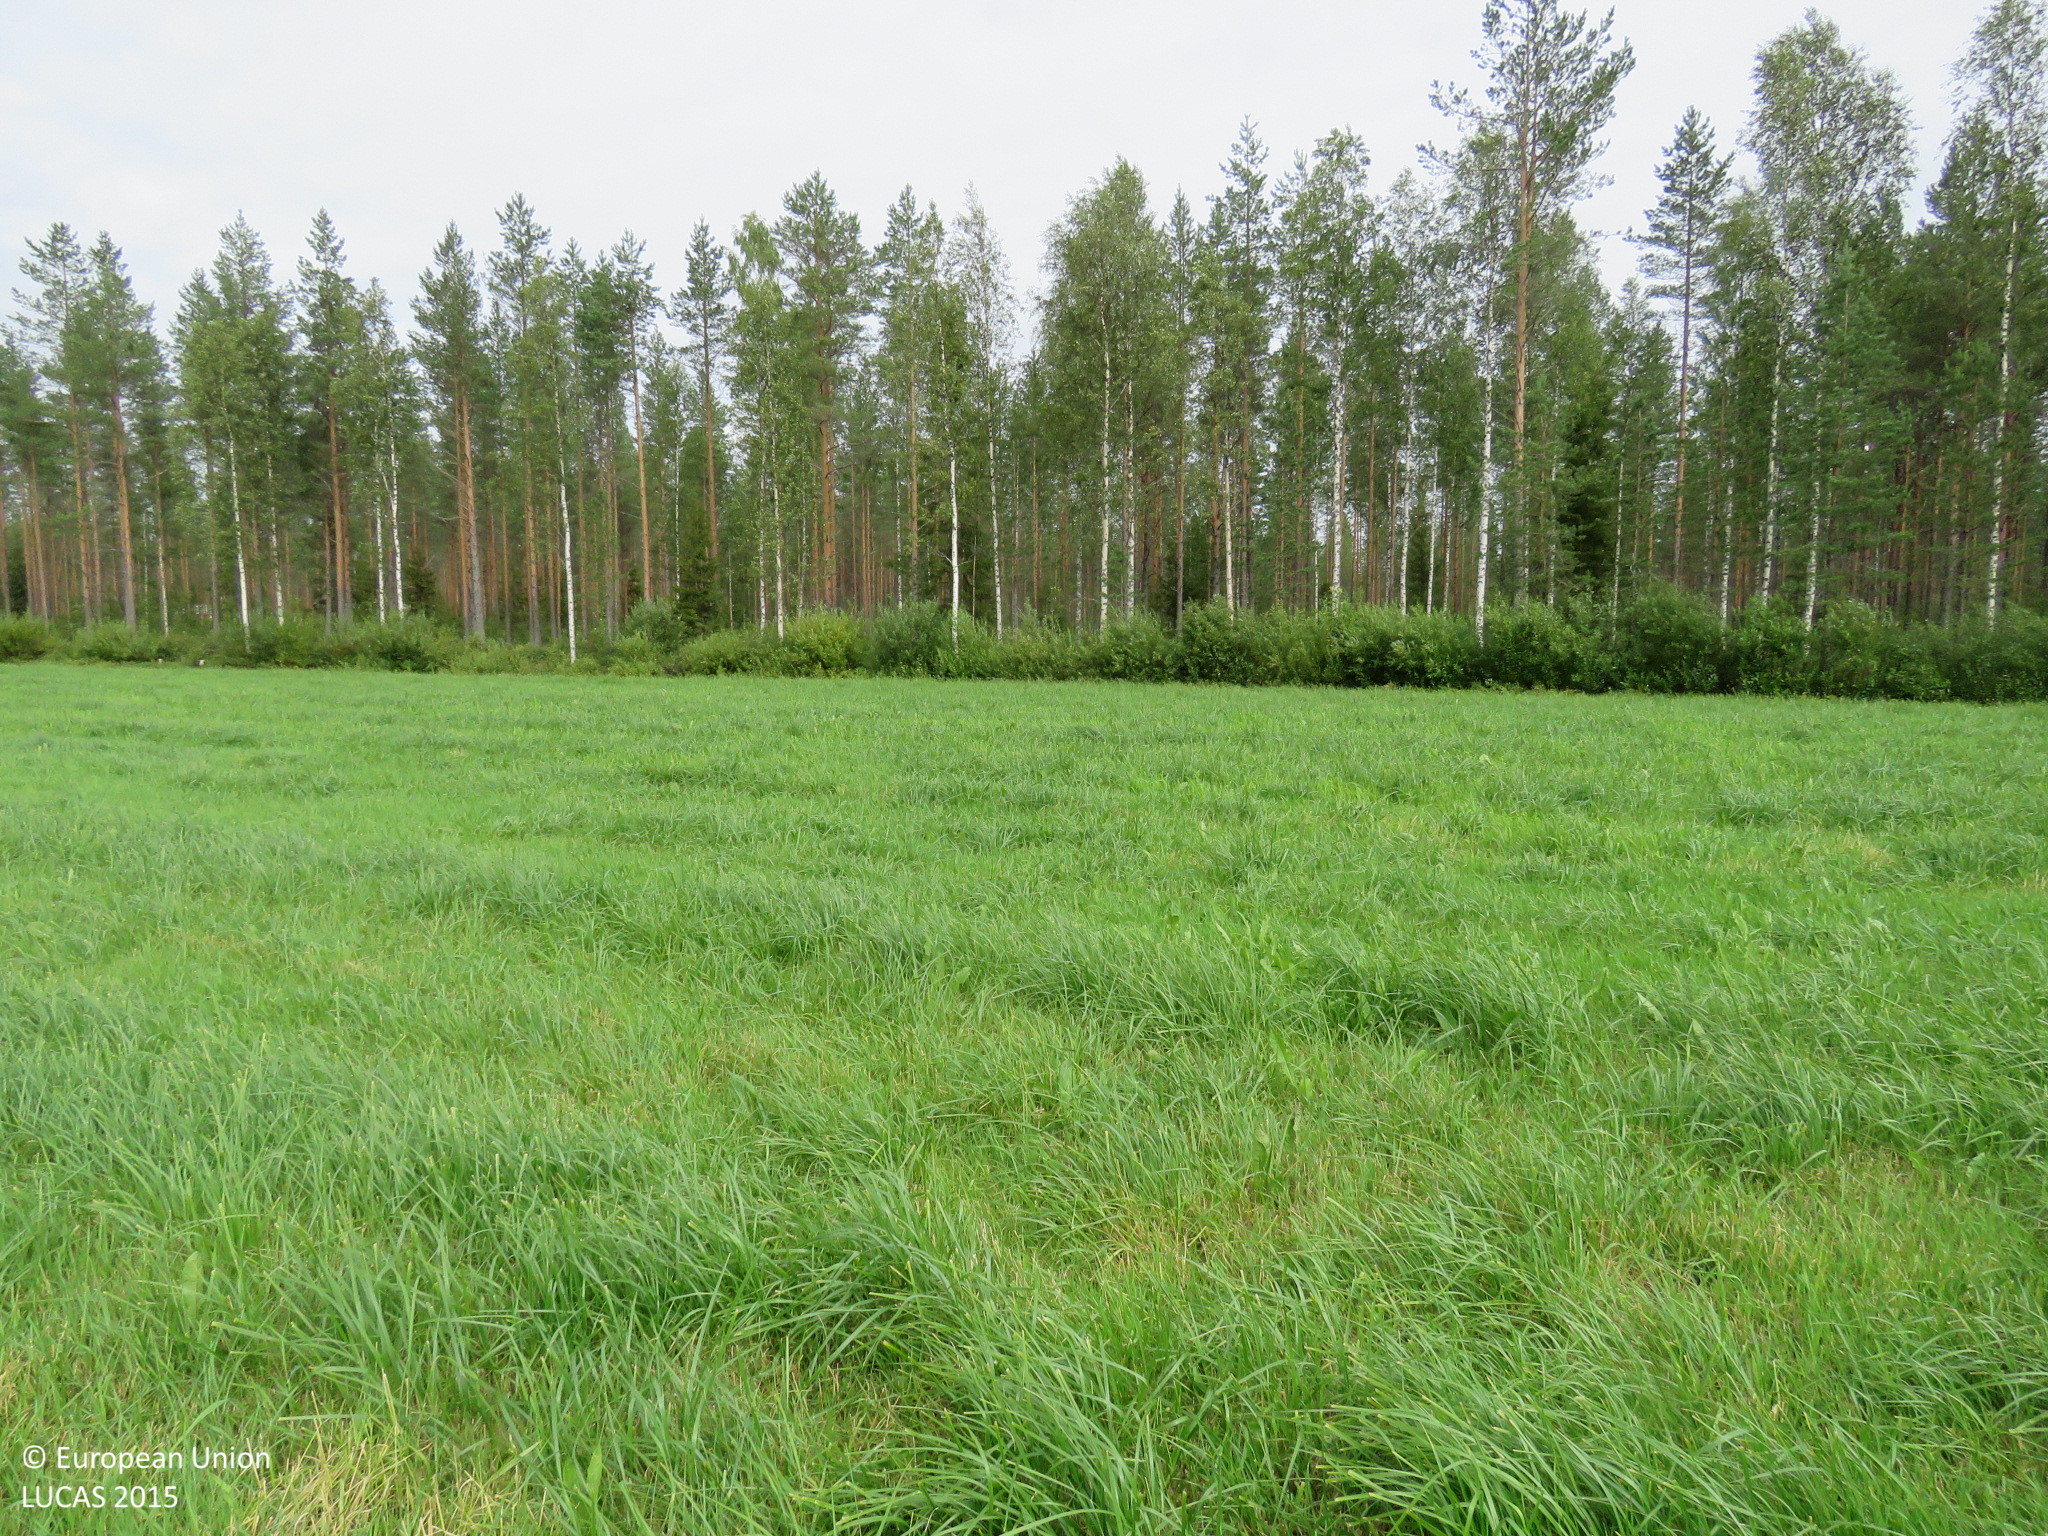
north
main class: Cropland
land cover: Temporary grasslands
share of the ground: > 75 %
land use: Agriculture (excluding fallow land and kitchen gardens)
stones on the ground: < 10 %
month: July
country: FI
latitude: 64.6085
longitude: 26.7791
